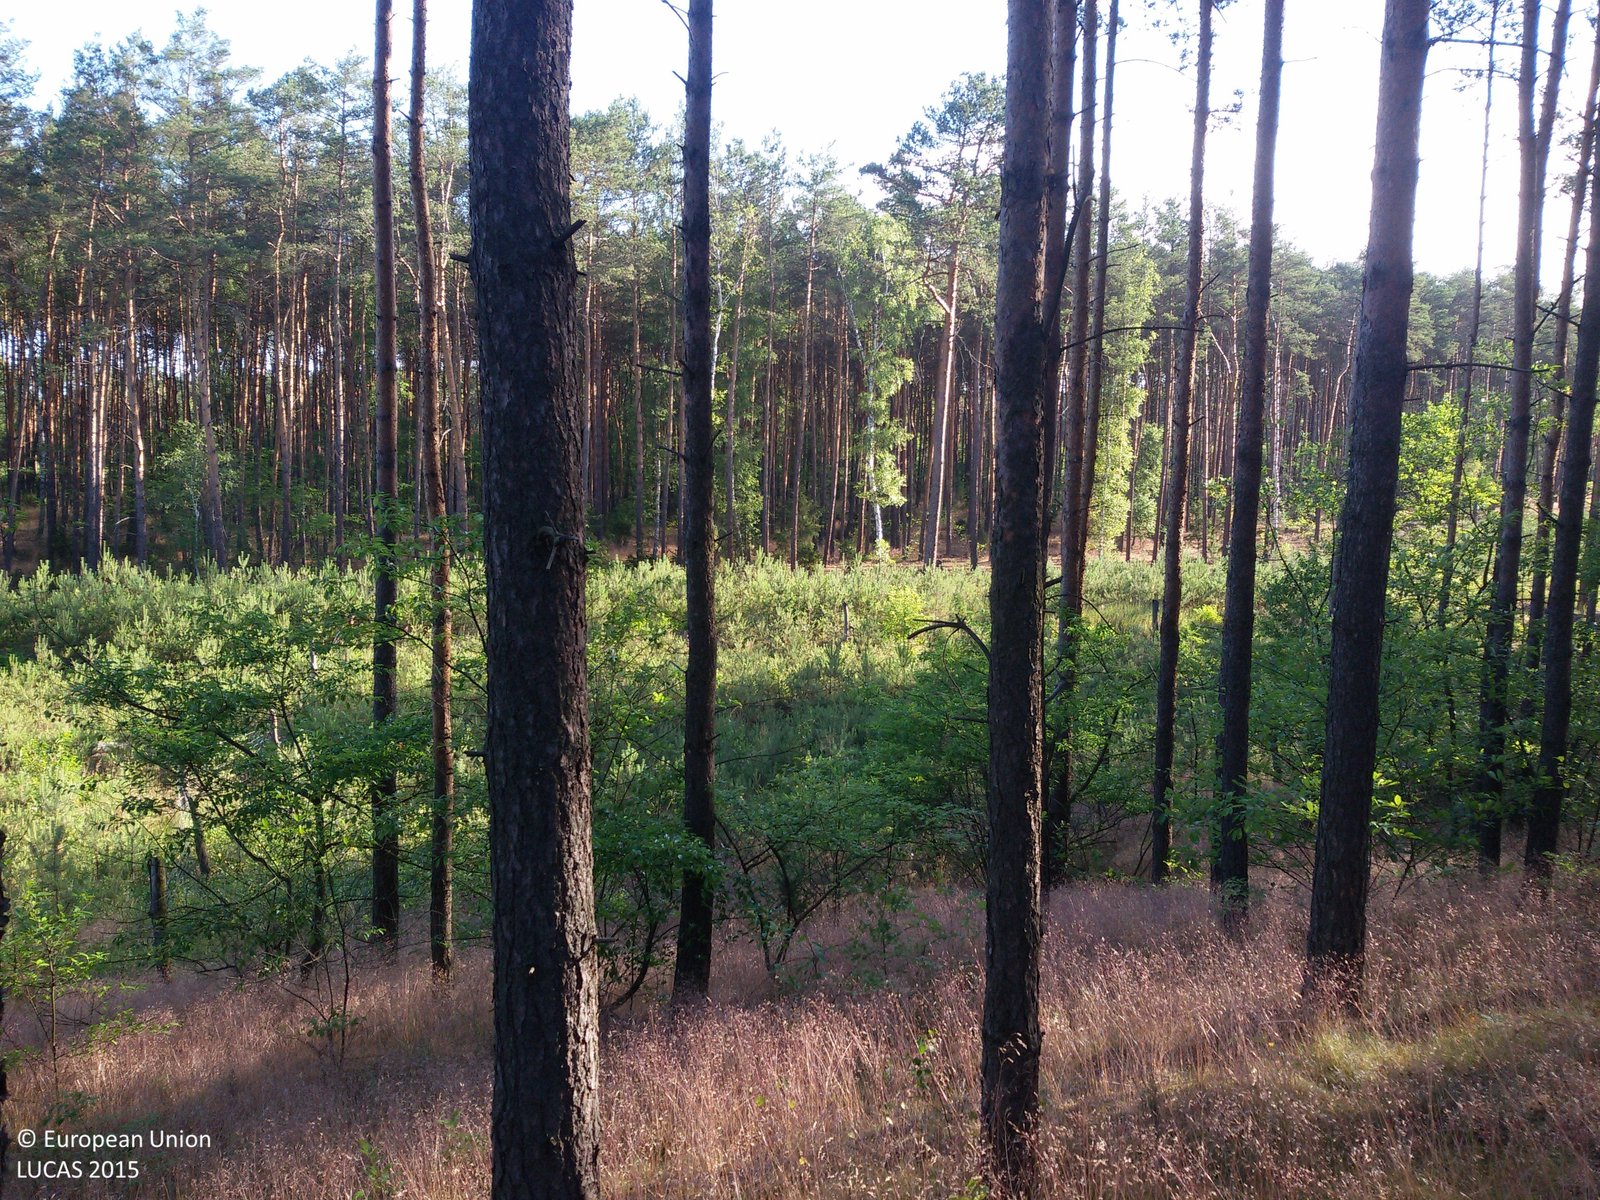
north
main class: Woodland
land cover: Pine dominated coniferous woodland
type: hemiboreal forest and nemoral coniferous forest and mixed broadleaved-coniferous forest
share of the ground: > 75 %
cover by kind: coniferous forest trees 80 %, herbaceous plants 10 %, shrubs 5 %, lichens and mosses 5 %
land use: Forestry
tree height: > 5 m
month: July
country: PL
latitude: 52.6105
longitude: 19.0465
